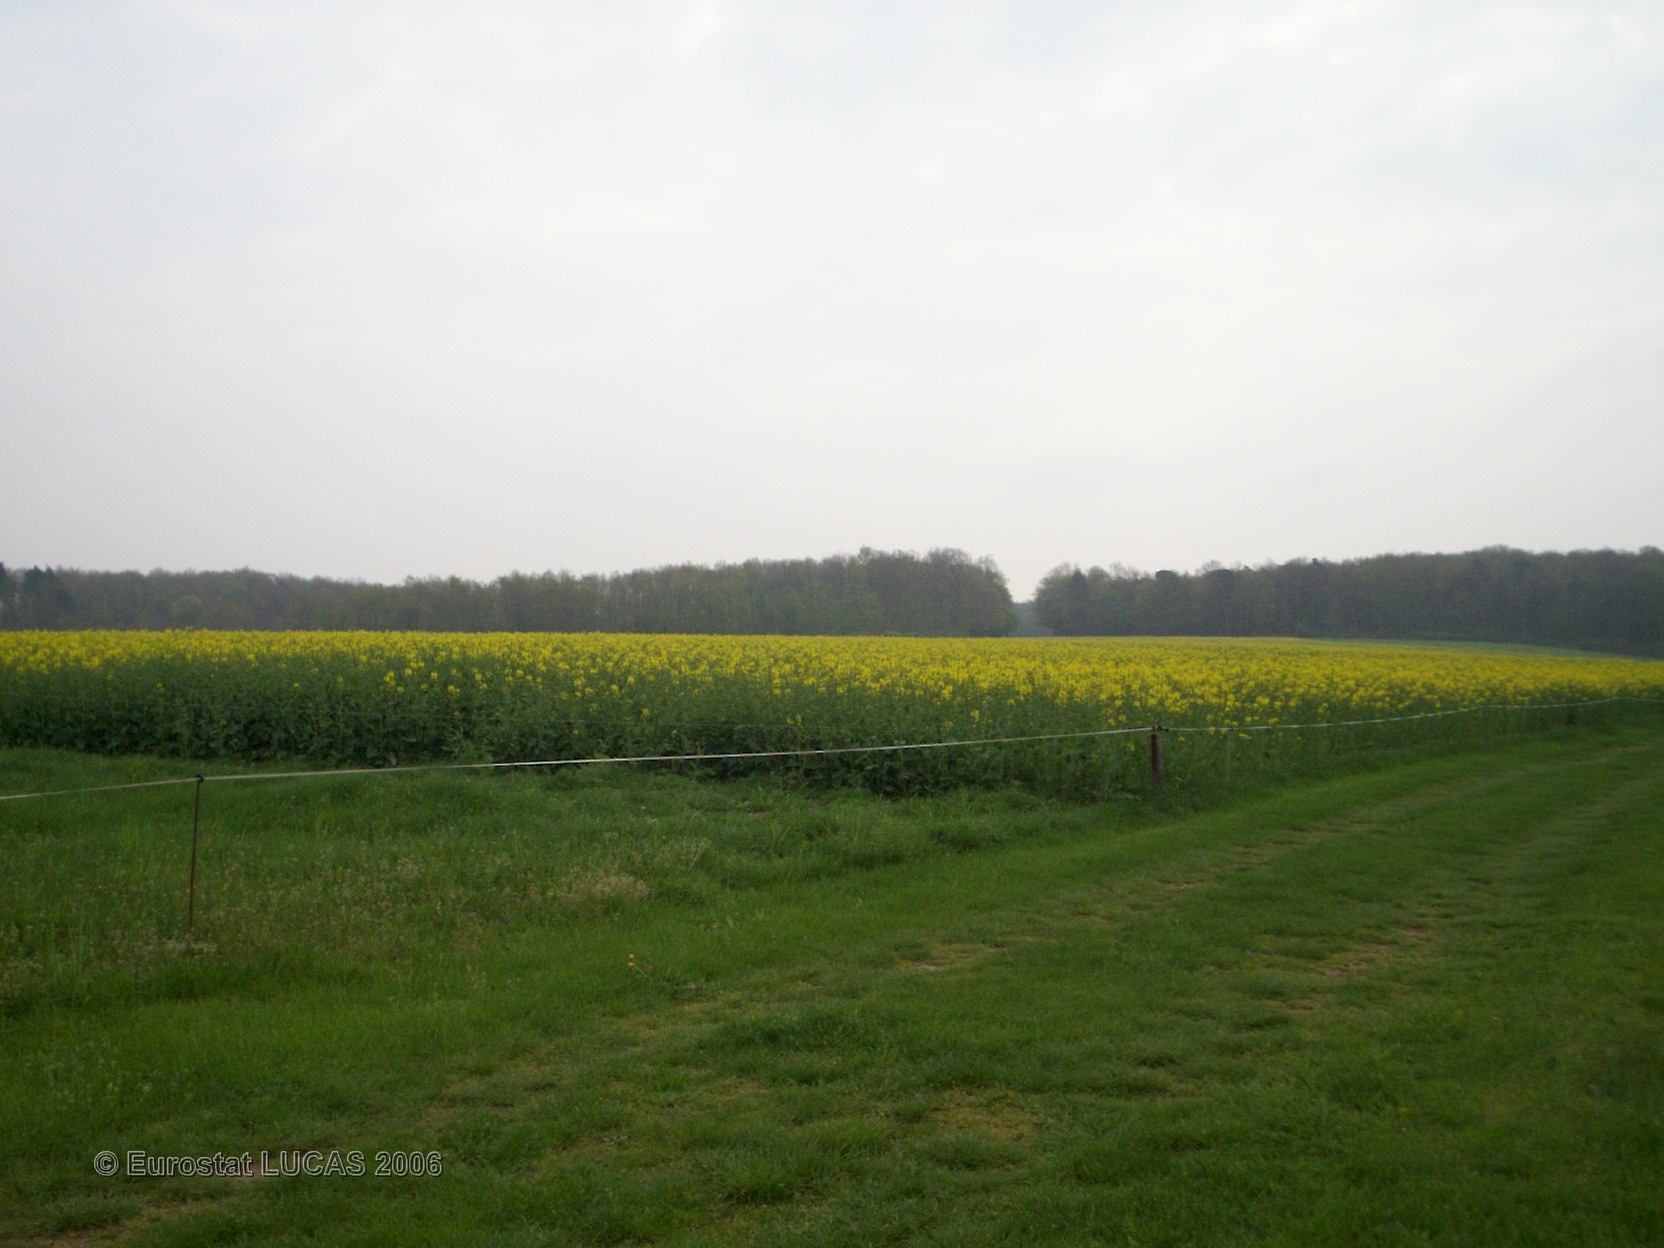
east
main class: Grassland
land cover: Grassland without tree/shrub cover
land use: Agriculture (excluding fallow land and kitchen gardens)
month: April
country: FR
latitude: 48.0109
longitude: 2.8741
